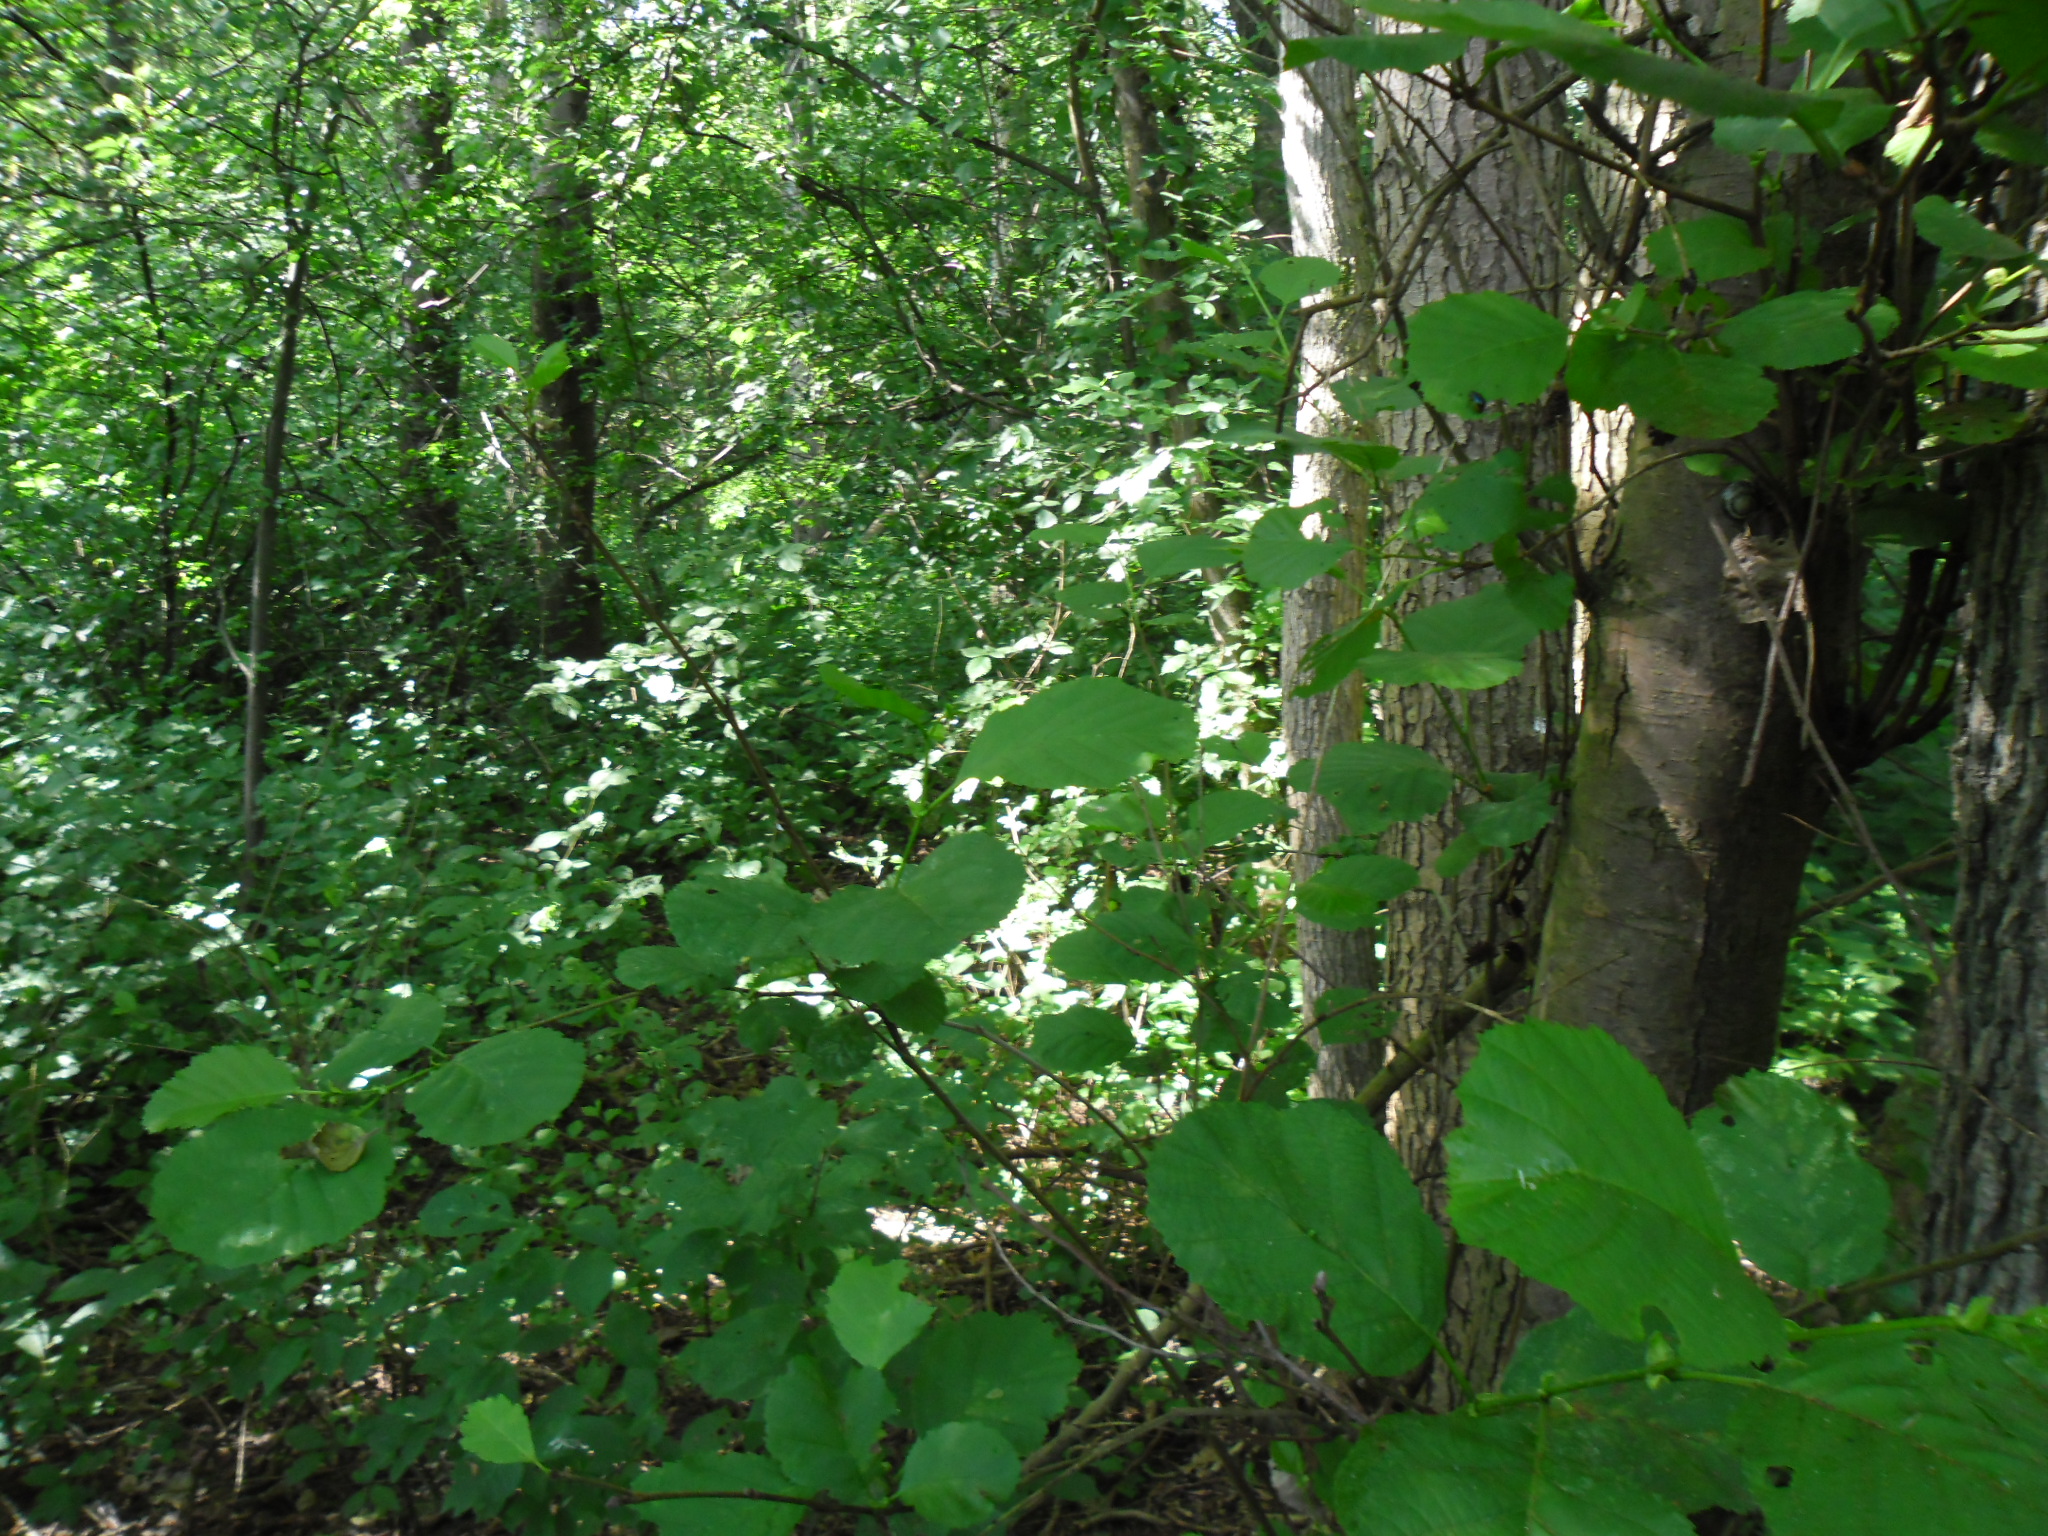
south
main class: Woodland
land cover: Broadleaved woodland
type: mesophytic deciduous forest
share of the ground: > 75 %
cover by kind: broadleaved forest trees 100 %
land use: Semi-natural and natural areas not in use
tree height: > 5 m
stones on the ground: < 10 %
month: June
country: NL
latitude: 52.6036
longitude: 5.6429
